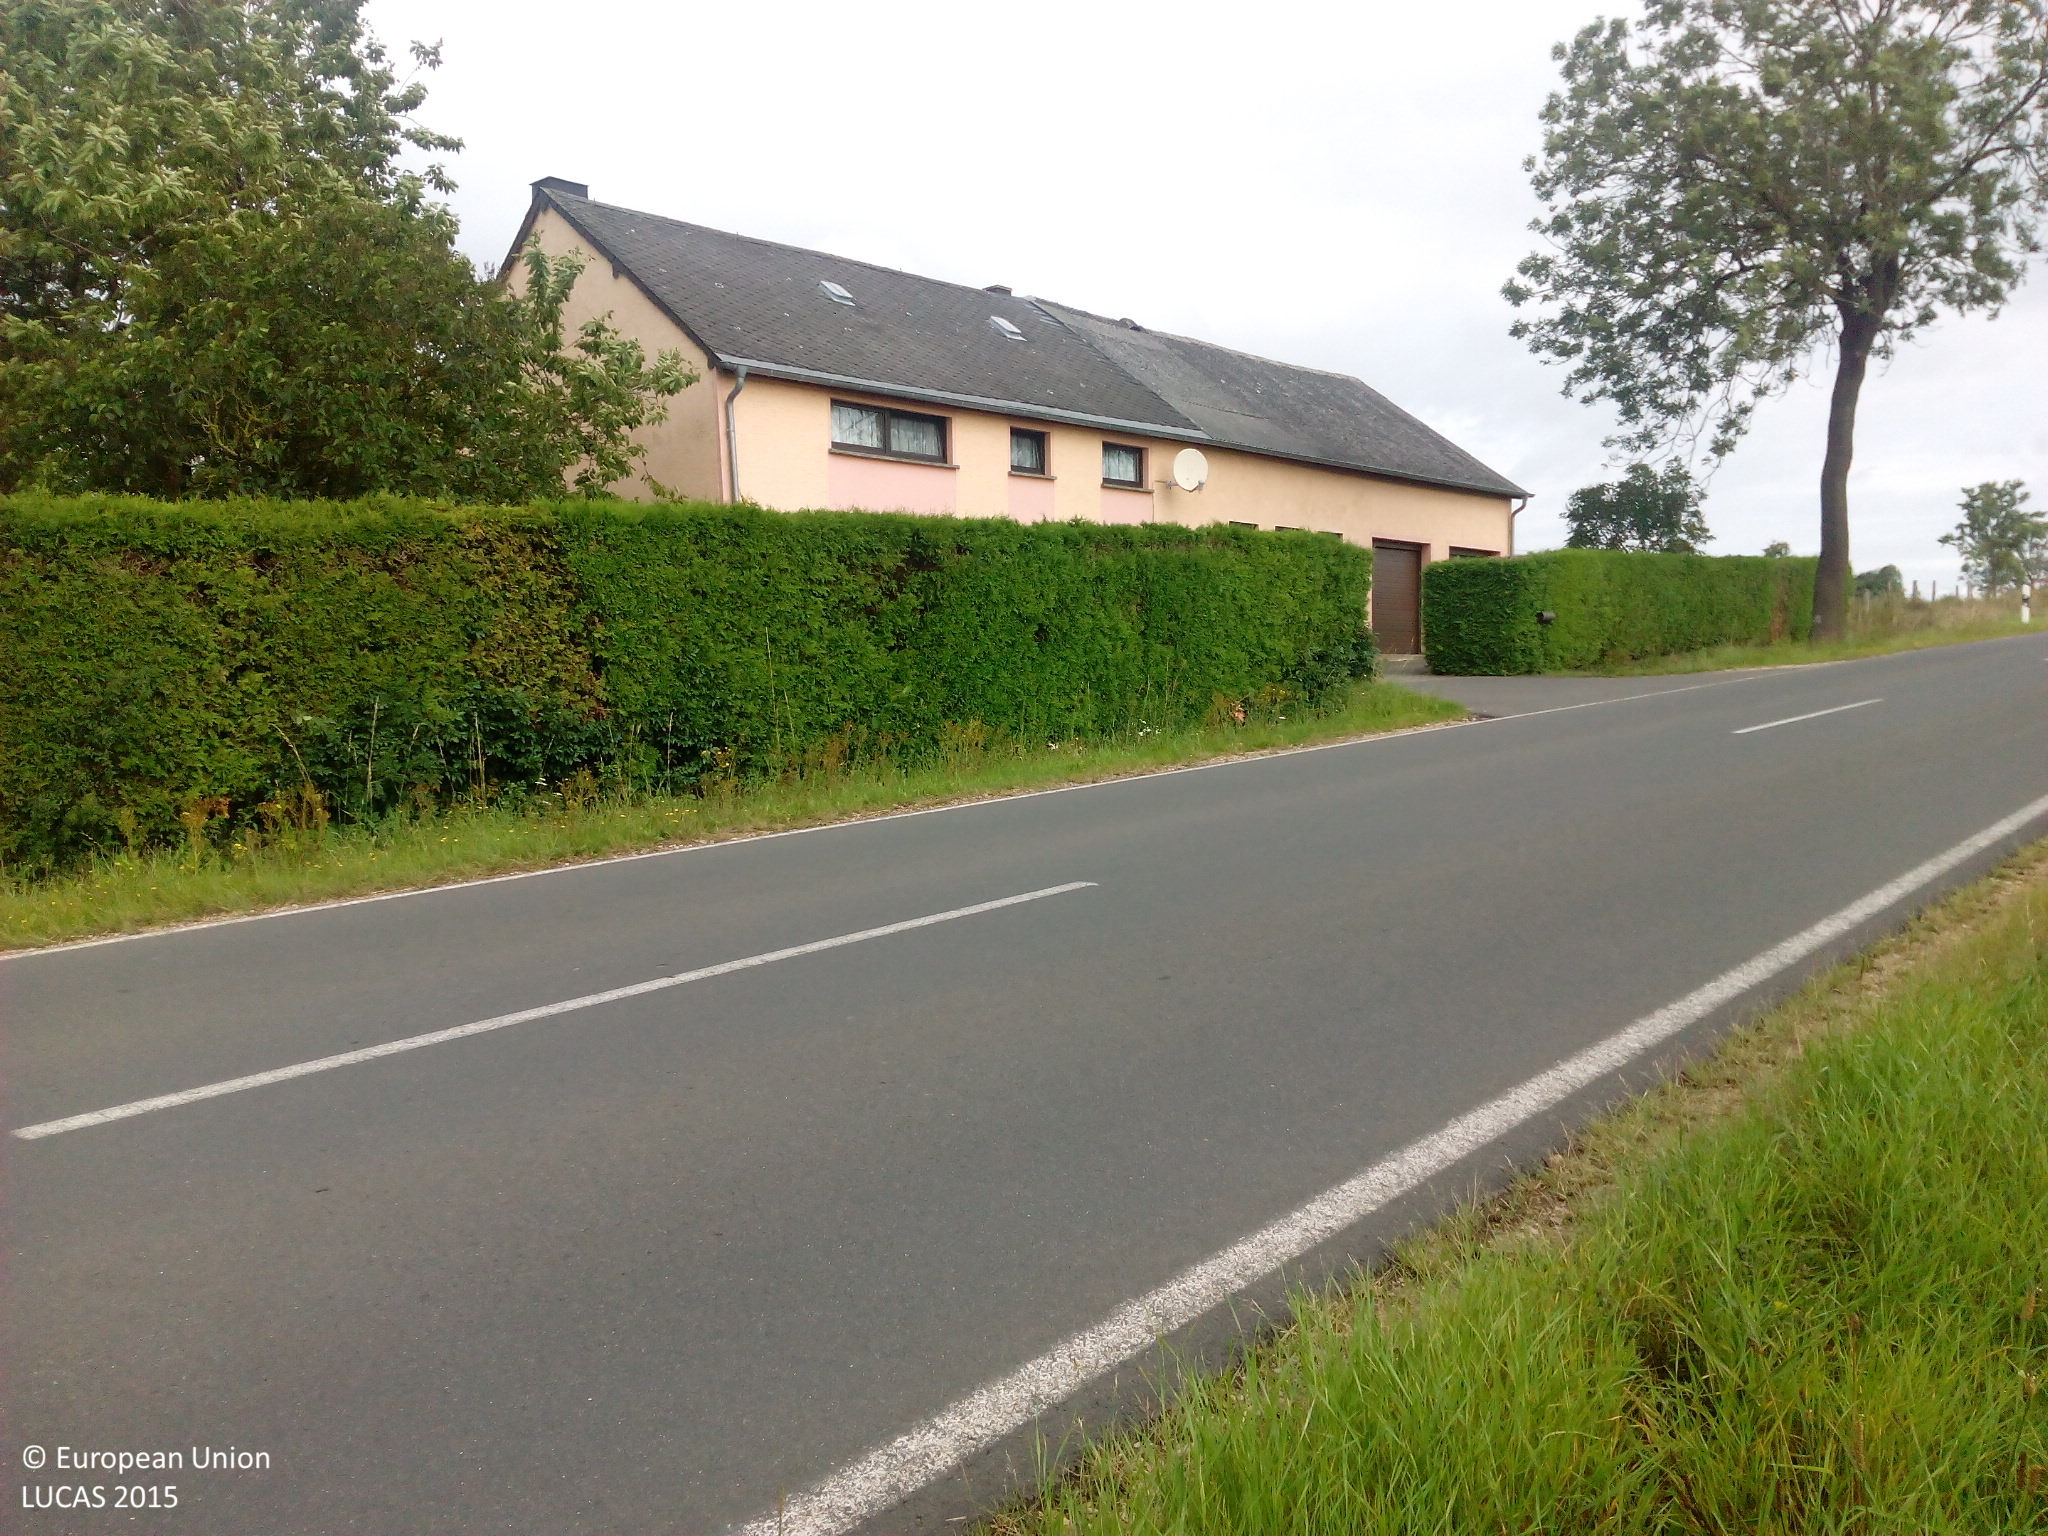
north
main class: Cropland
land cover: Maize
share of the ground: > 75 %
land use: Agriculture (excluding fallow land and kitchen gardens)
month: August
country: DE
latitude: 50.2497
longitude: 6.2830
